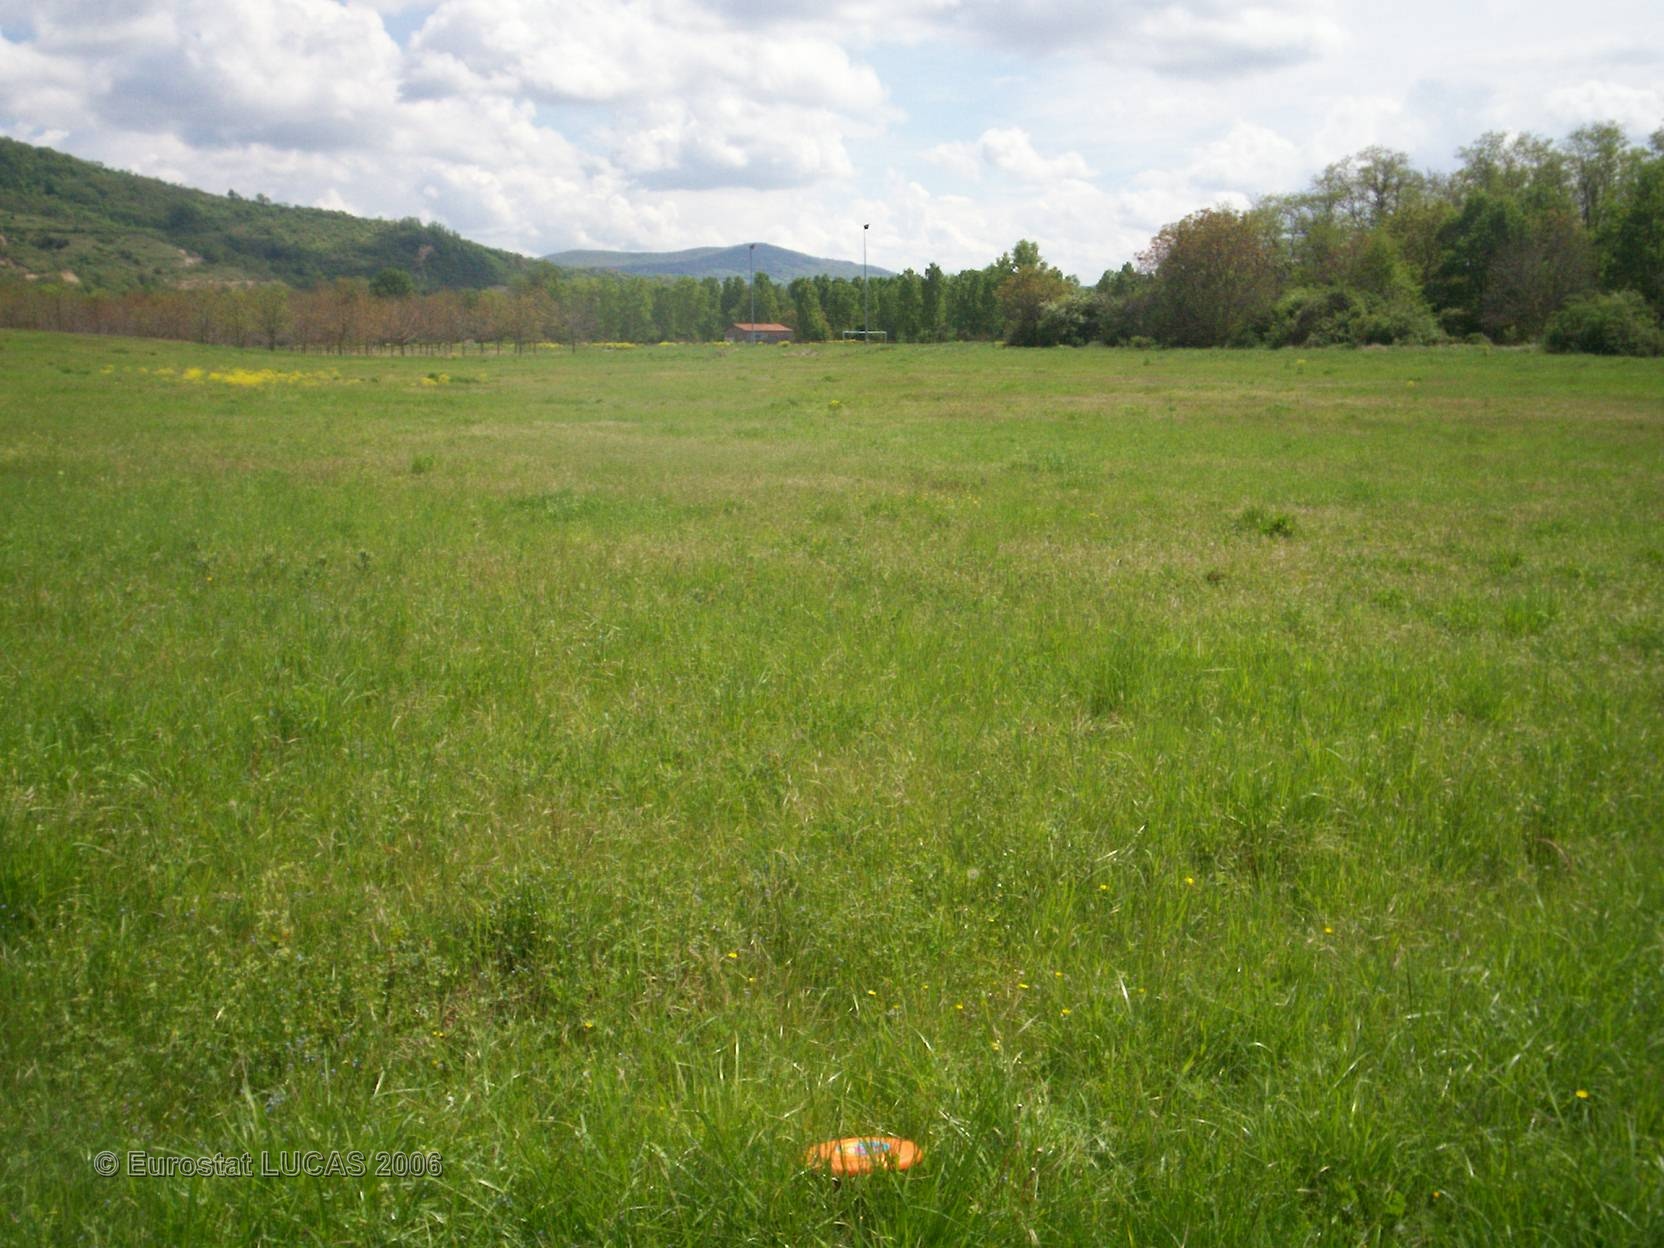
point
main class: Grassland
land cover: Grassland without tree/shrub cover
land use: Agriculture (excluding fallow land and kitchen gardens)
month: May
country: FR
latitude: 45.6834
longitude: 3.2084
